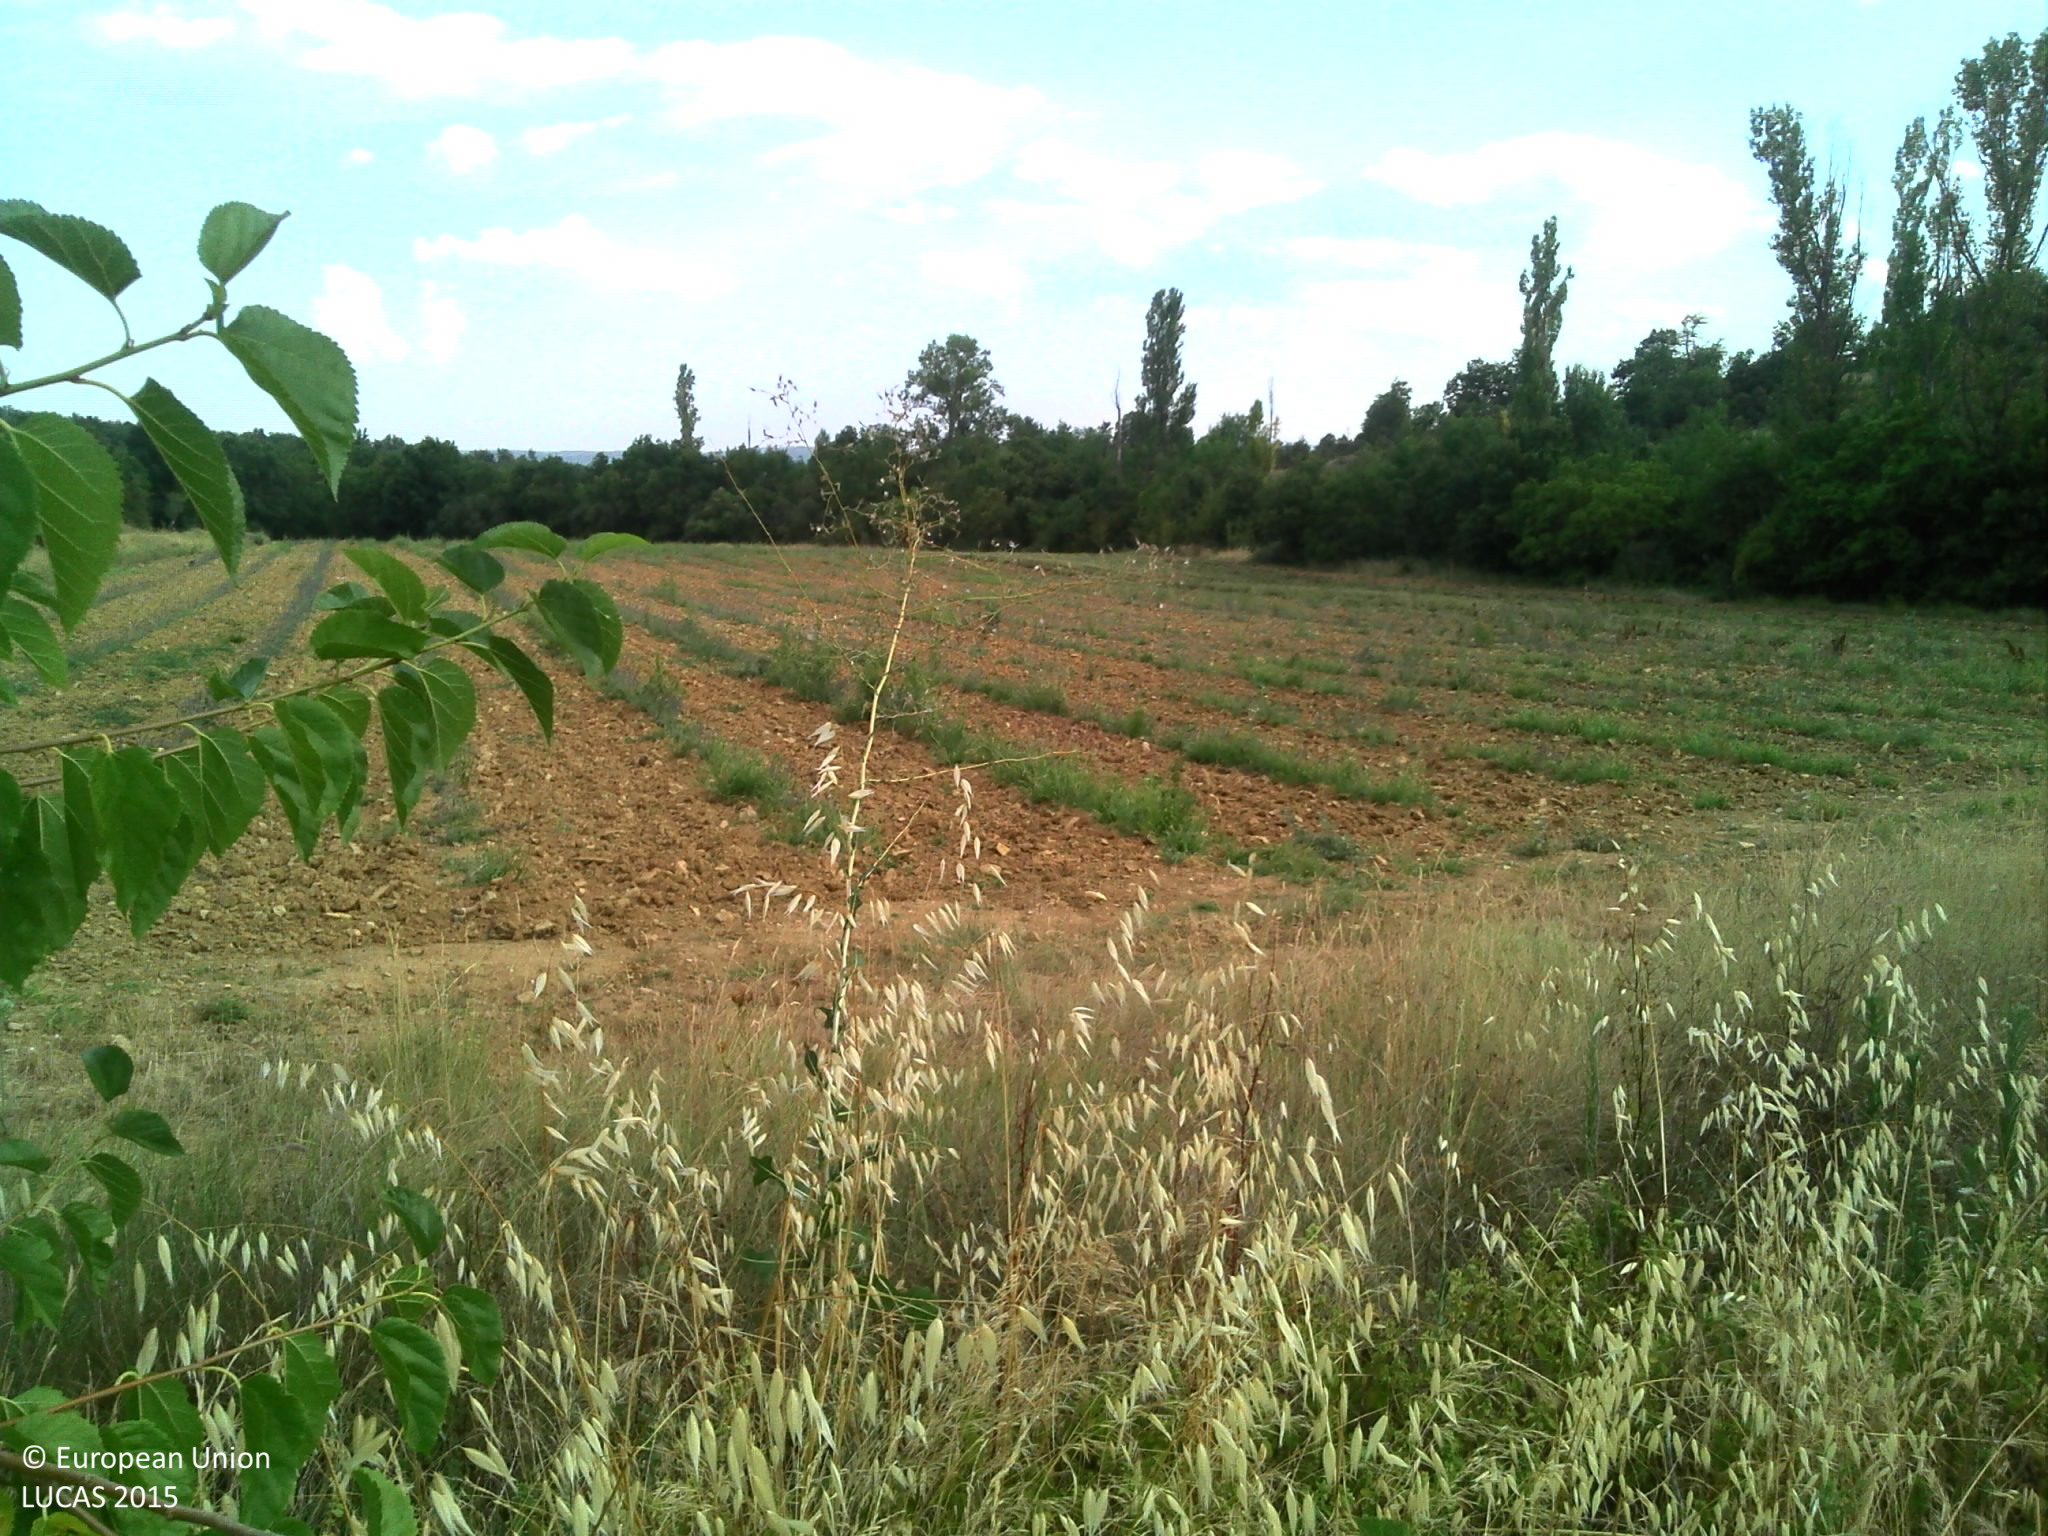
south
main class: Cropland
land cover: Tomatoes
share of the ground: 10 - 25 %
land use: Agriculture (excluding fallow land and kitchen gardens)
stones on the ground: 25 - 50 %
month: July
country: FR
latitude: 44.3399
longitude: 4.3252
